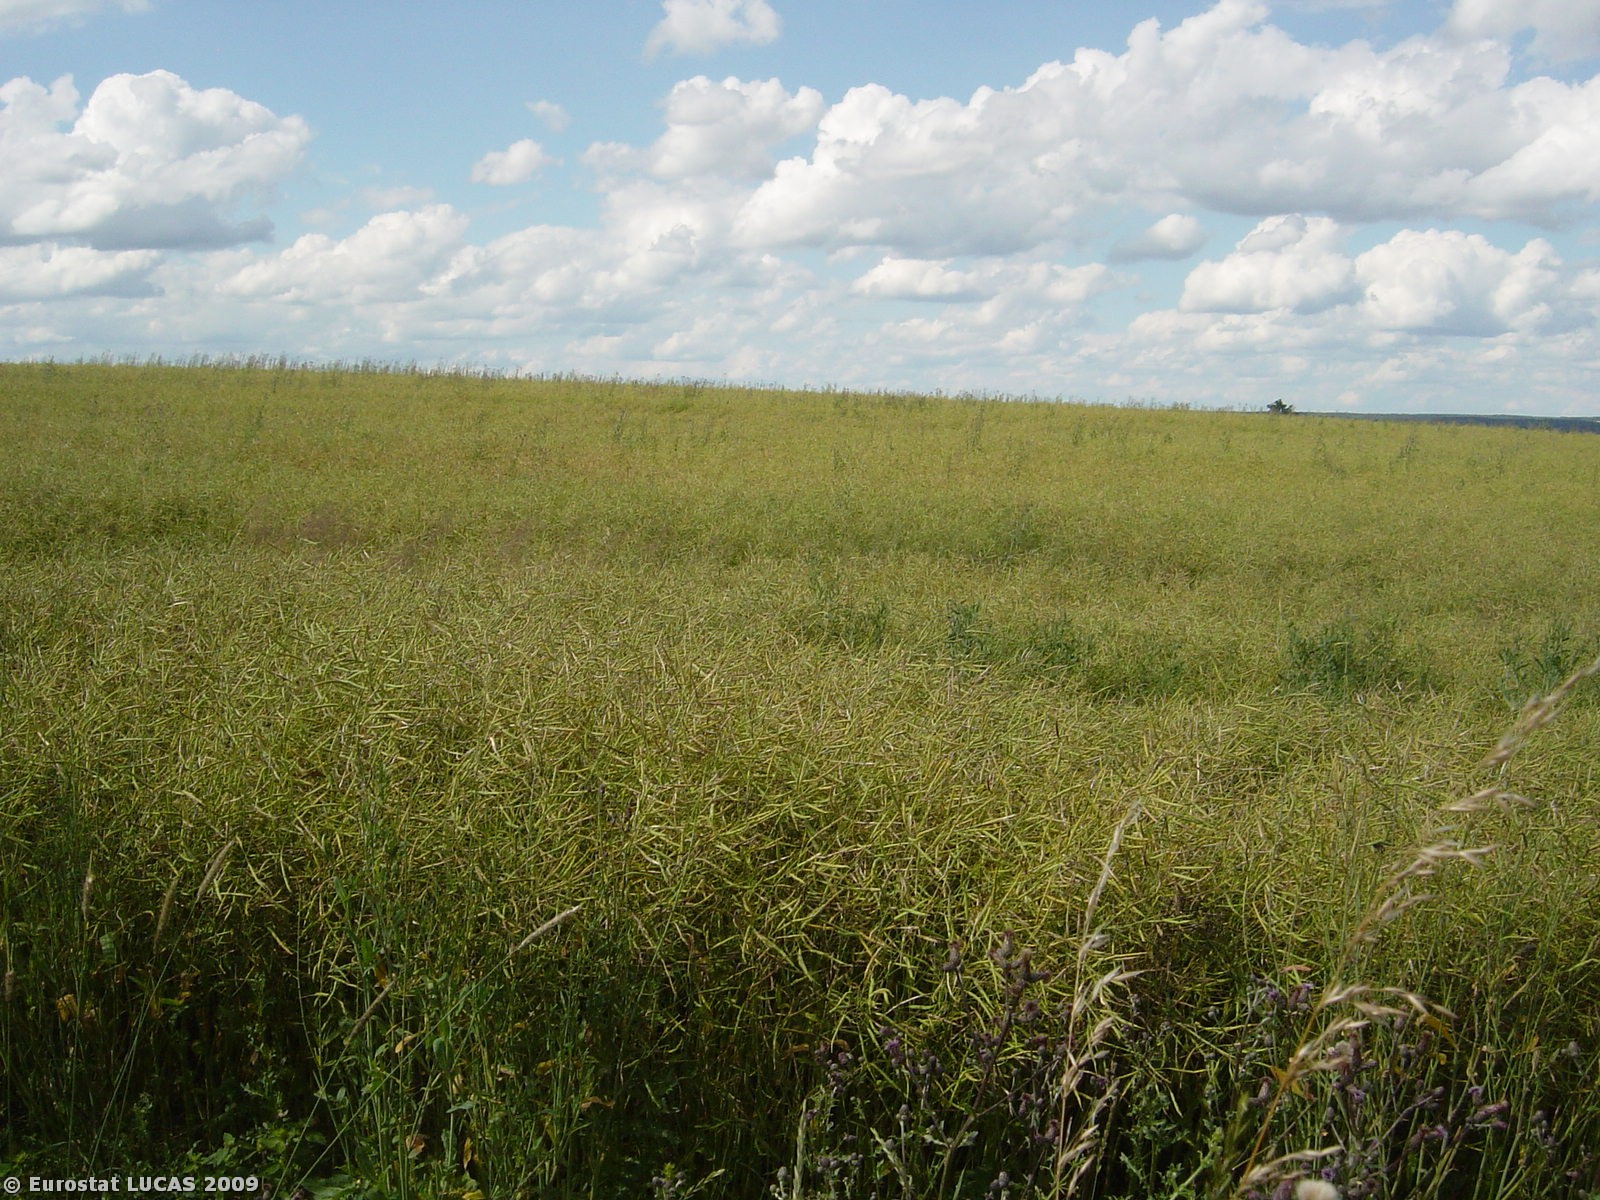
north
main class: Grassland
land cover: Spontaneously vegetated surfaces
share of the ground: > 75 %
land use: Unused
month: July
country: CZ
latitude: 49.7335
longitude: 12.8995
